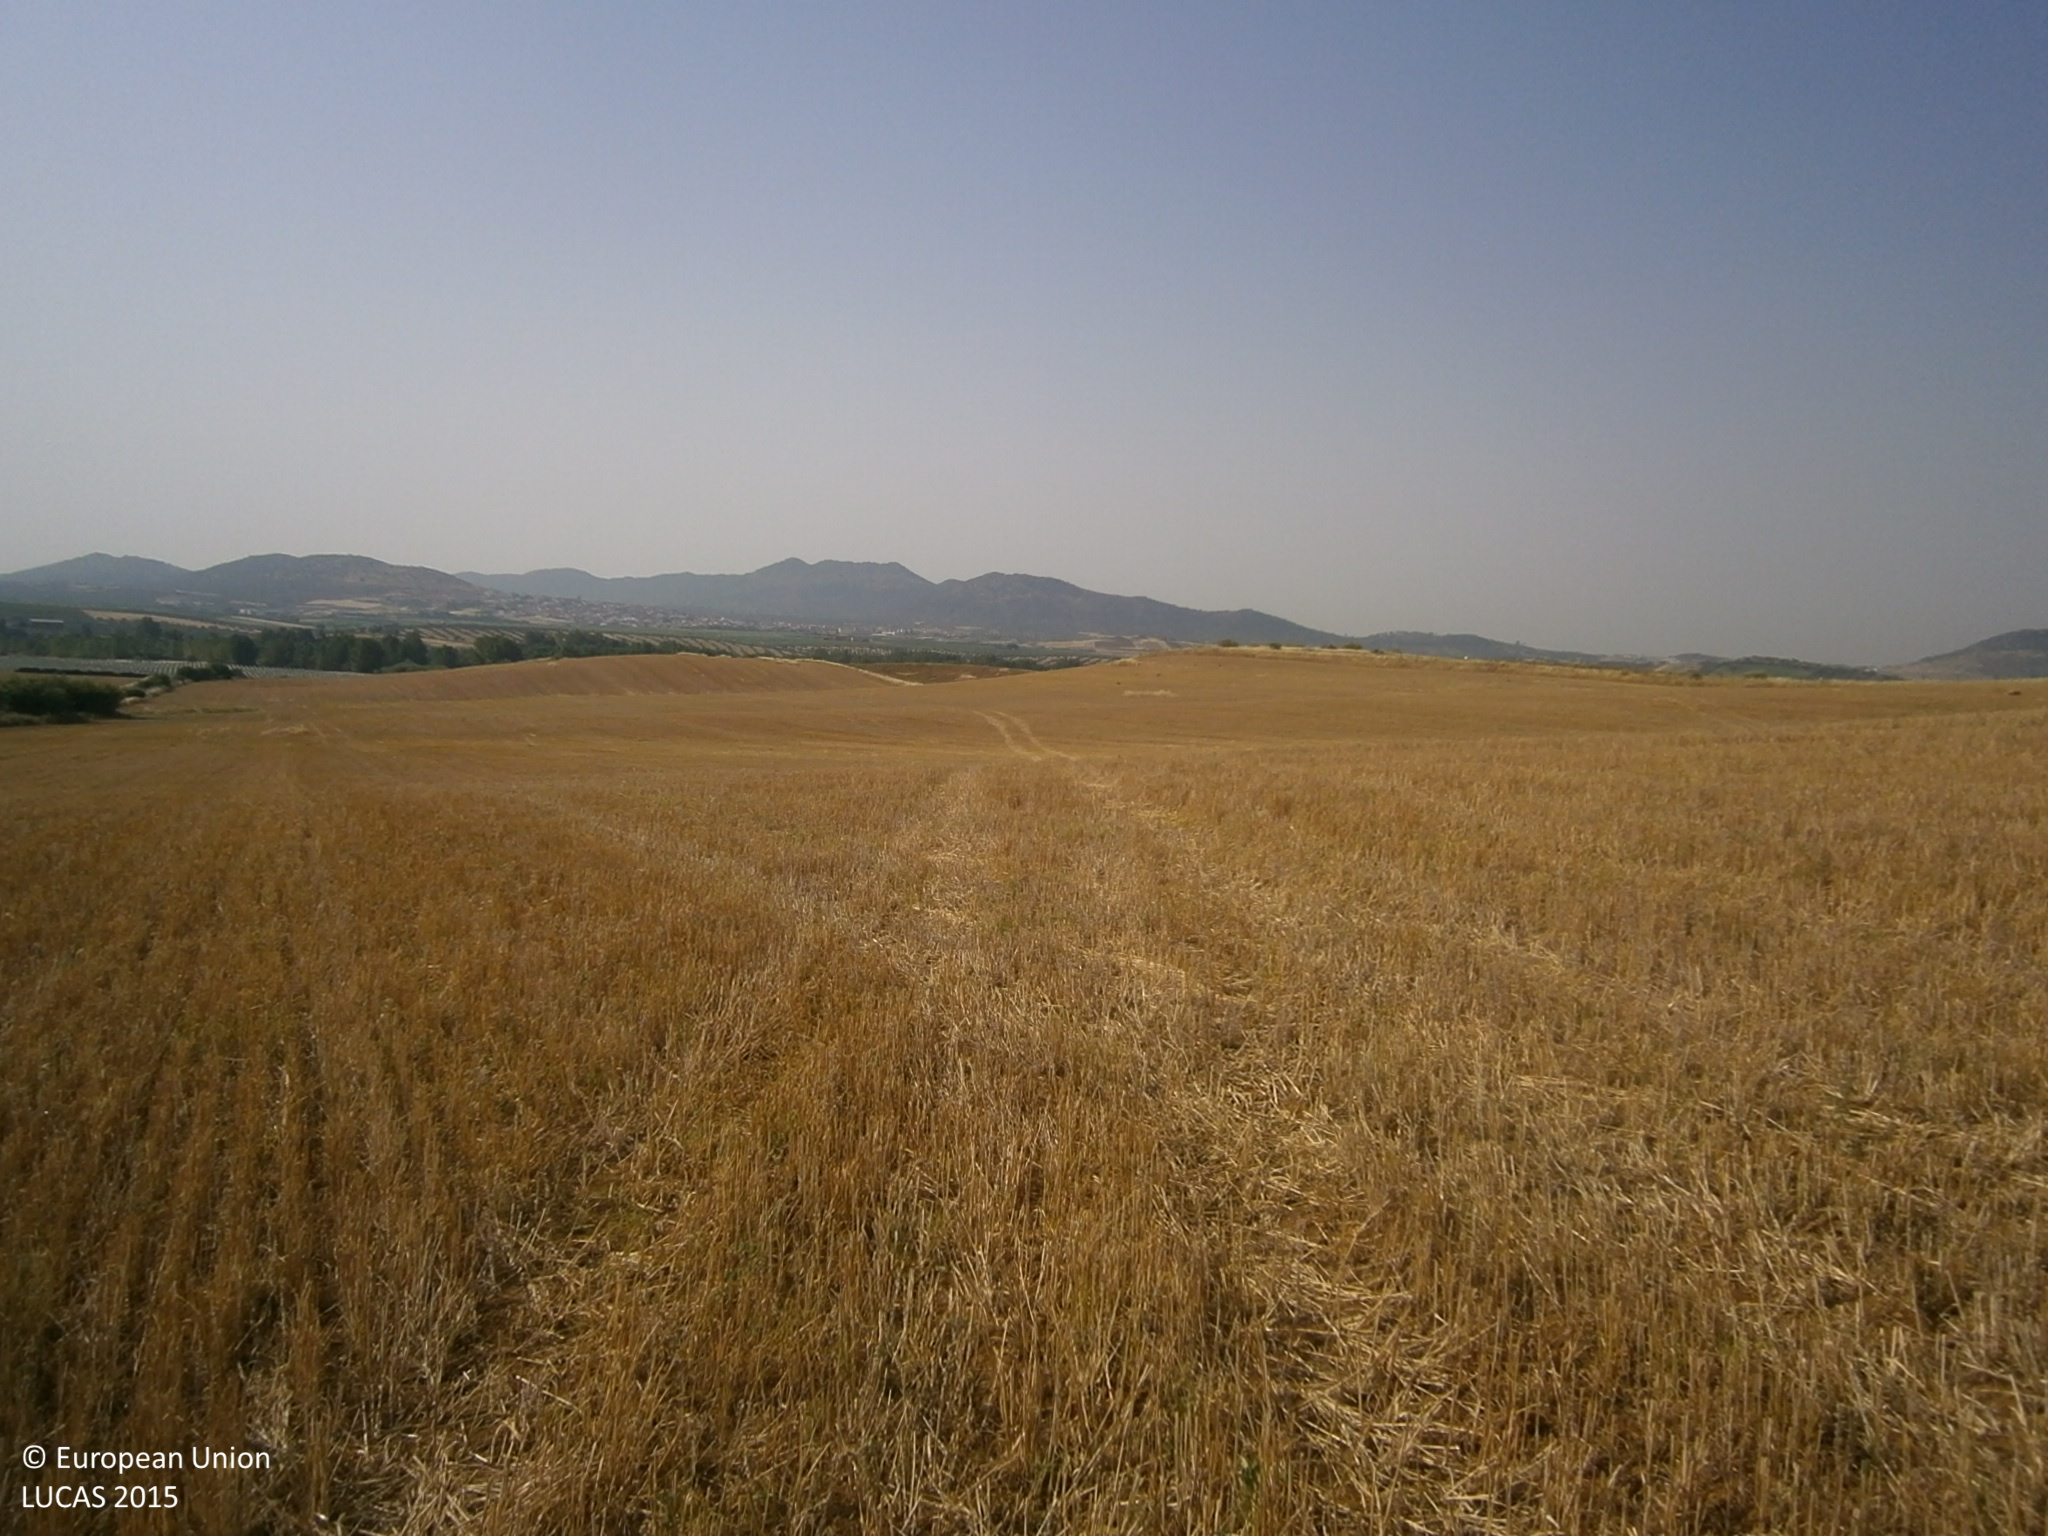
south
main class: Cropland
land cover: Temporary grasslands
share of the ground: > 75 %
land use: Agriculture (excluding fallow land and kitchen gardens)
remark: Harvested field
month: June
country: ES
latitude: 38.8483
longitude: -6.2431
